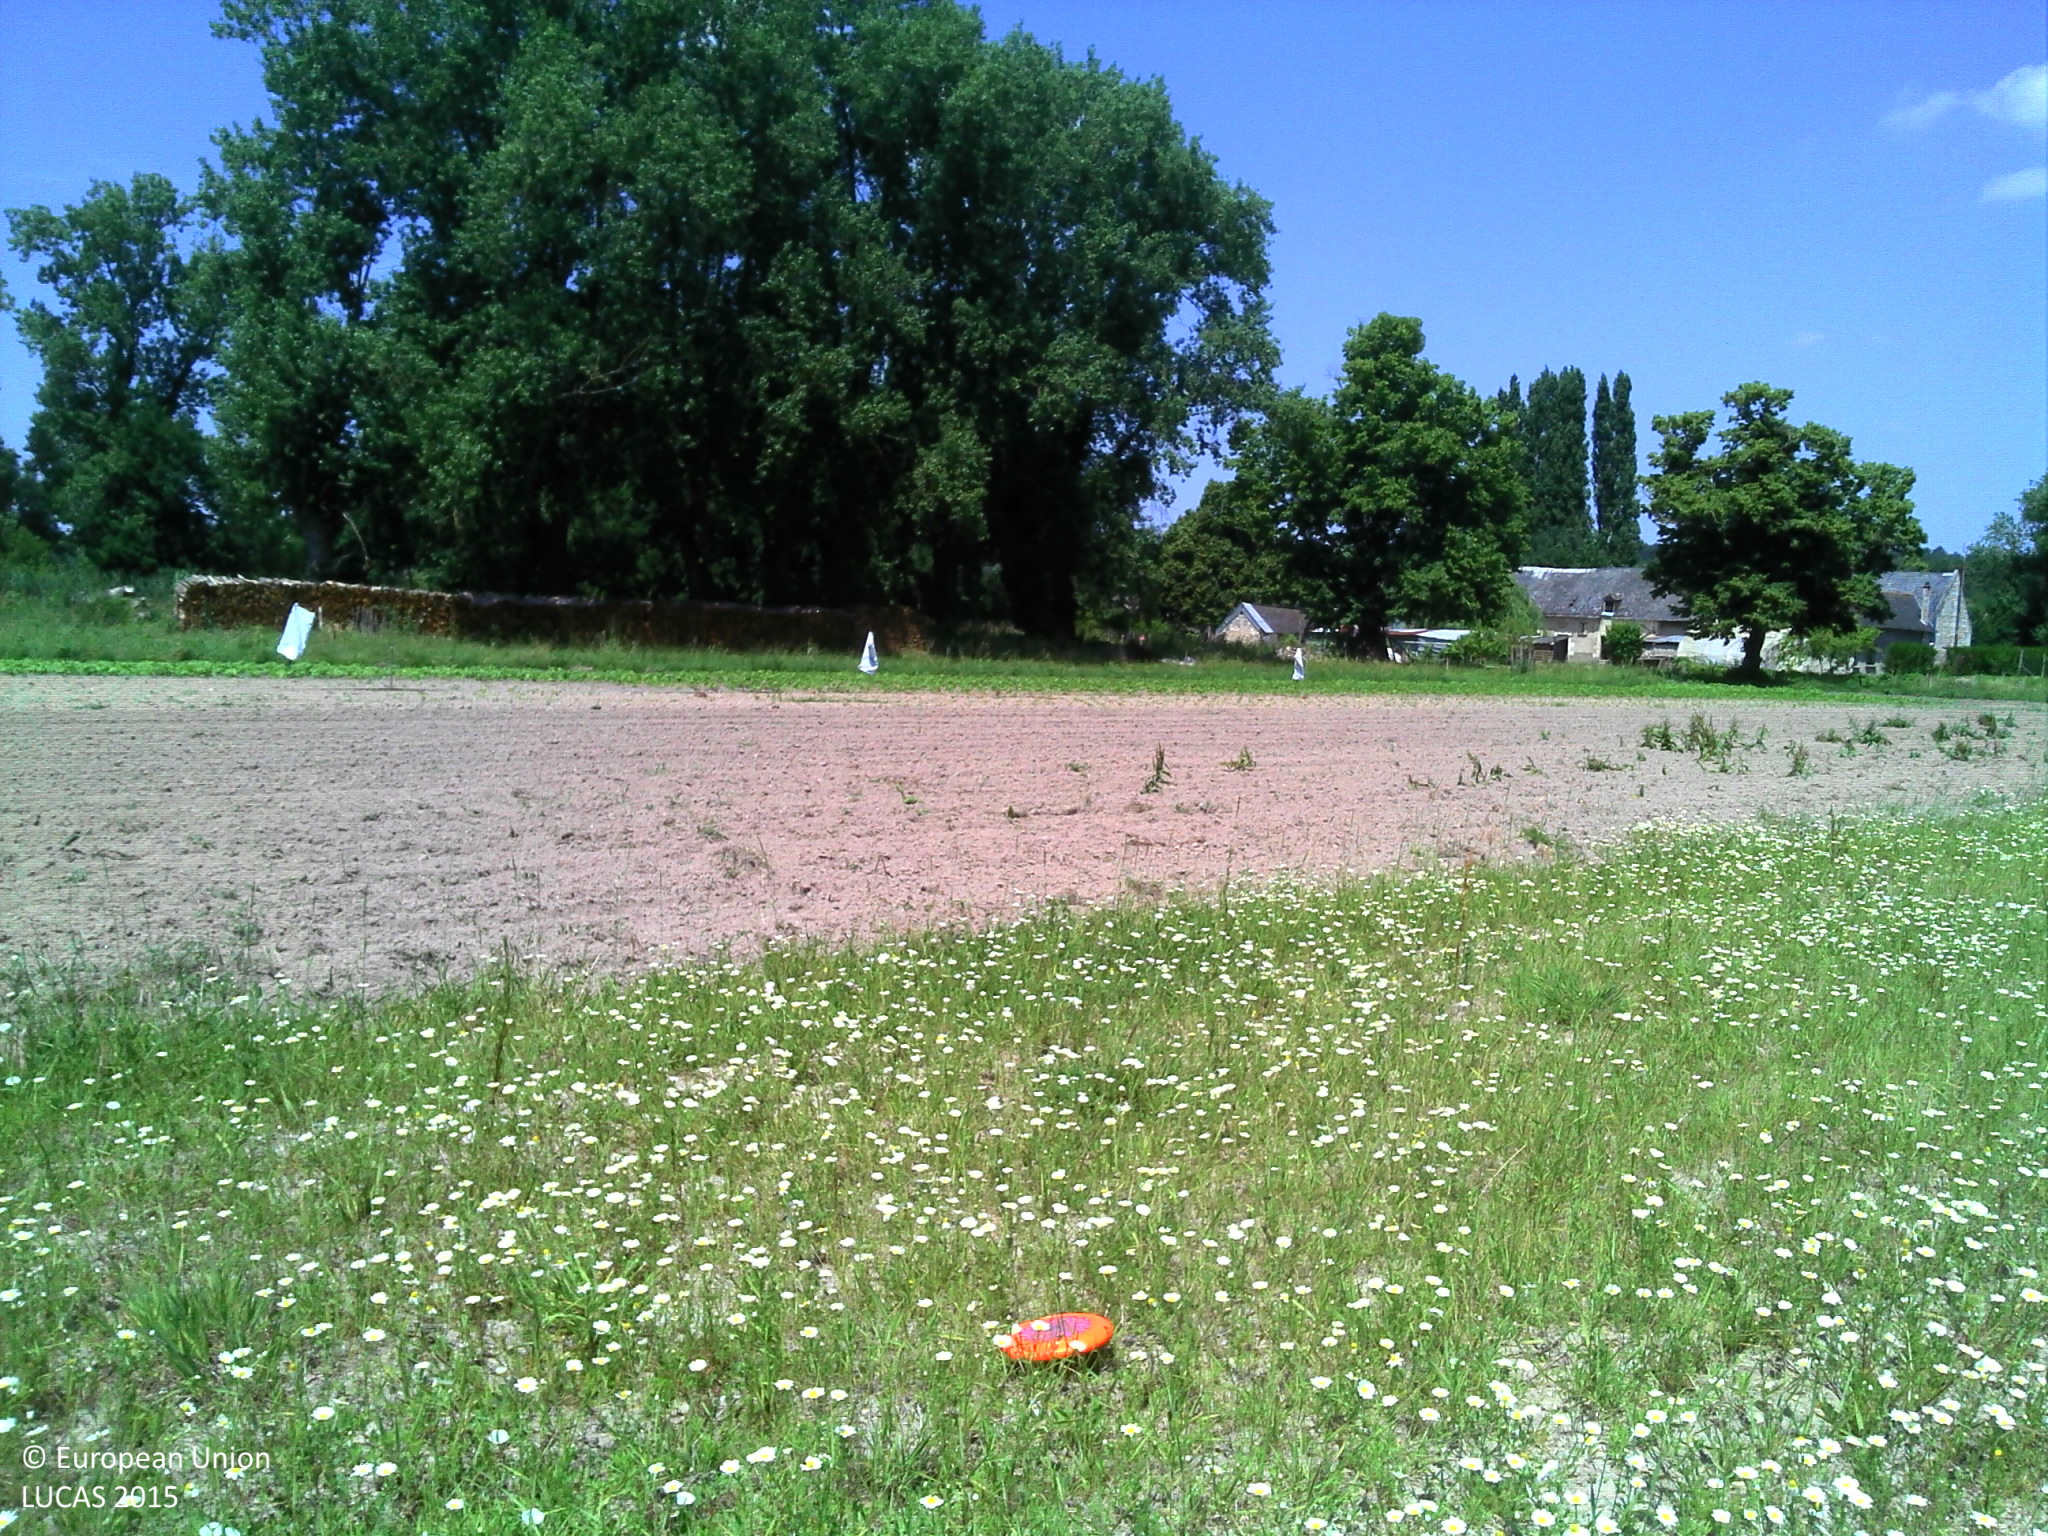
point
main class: Cropland
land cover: Temporary grasslands
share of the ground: > 75 %
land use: Agriculture (excluding fallow land and kitchen gardens)
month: June
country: FR
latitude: 47.3003
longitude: 0.0431
